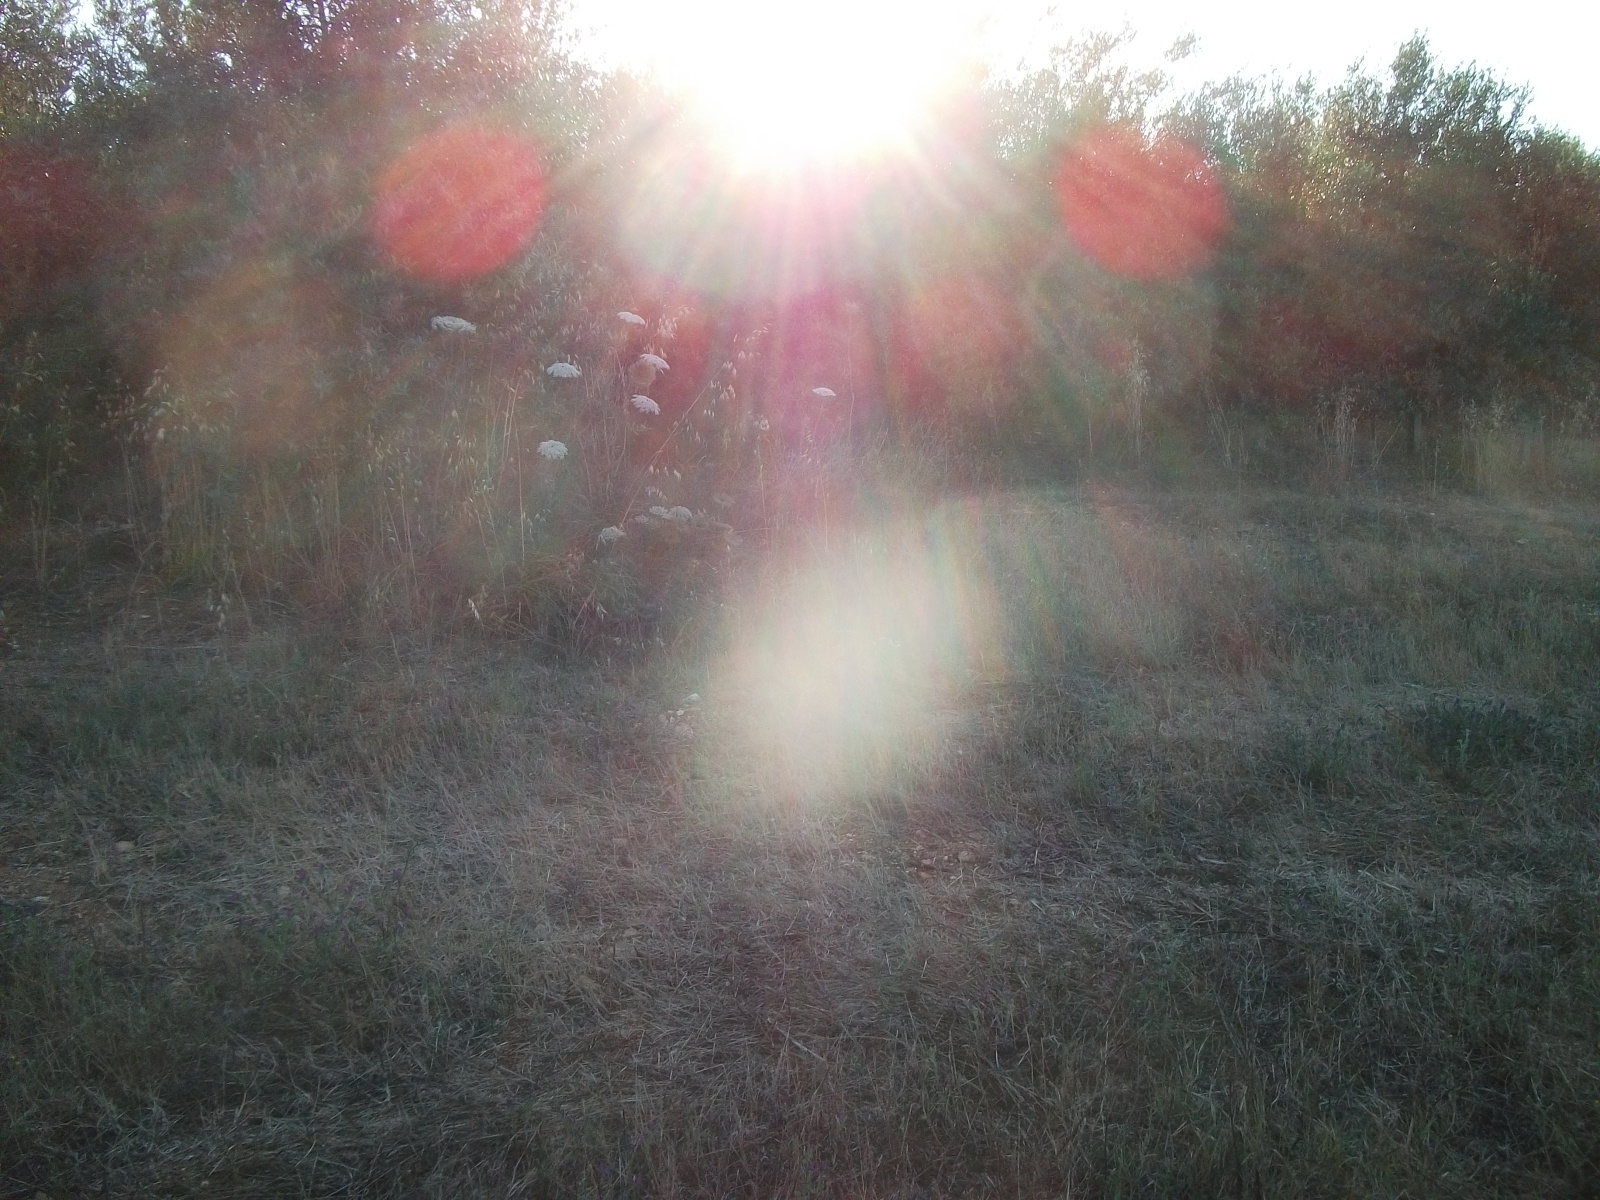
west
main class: Grassland
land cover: Spontaneously vegetated surfaces
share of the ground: > 75 %
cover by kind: herbaceous plants 100 %
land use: Fallow land
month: June
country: ES
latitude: 37.4161
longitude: -6.6335
